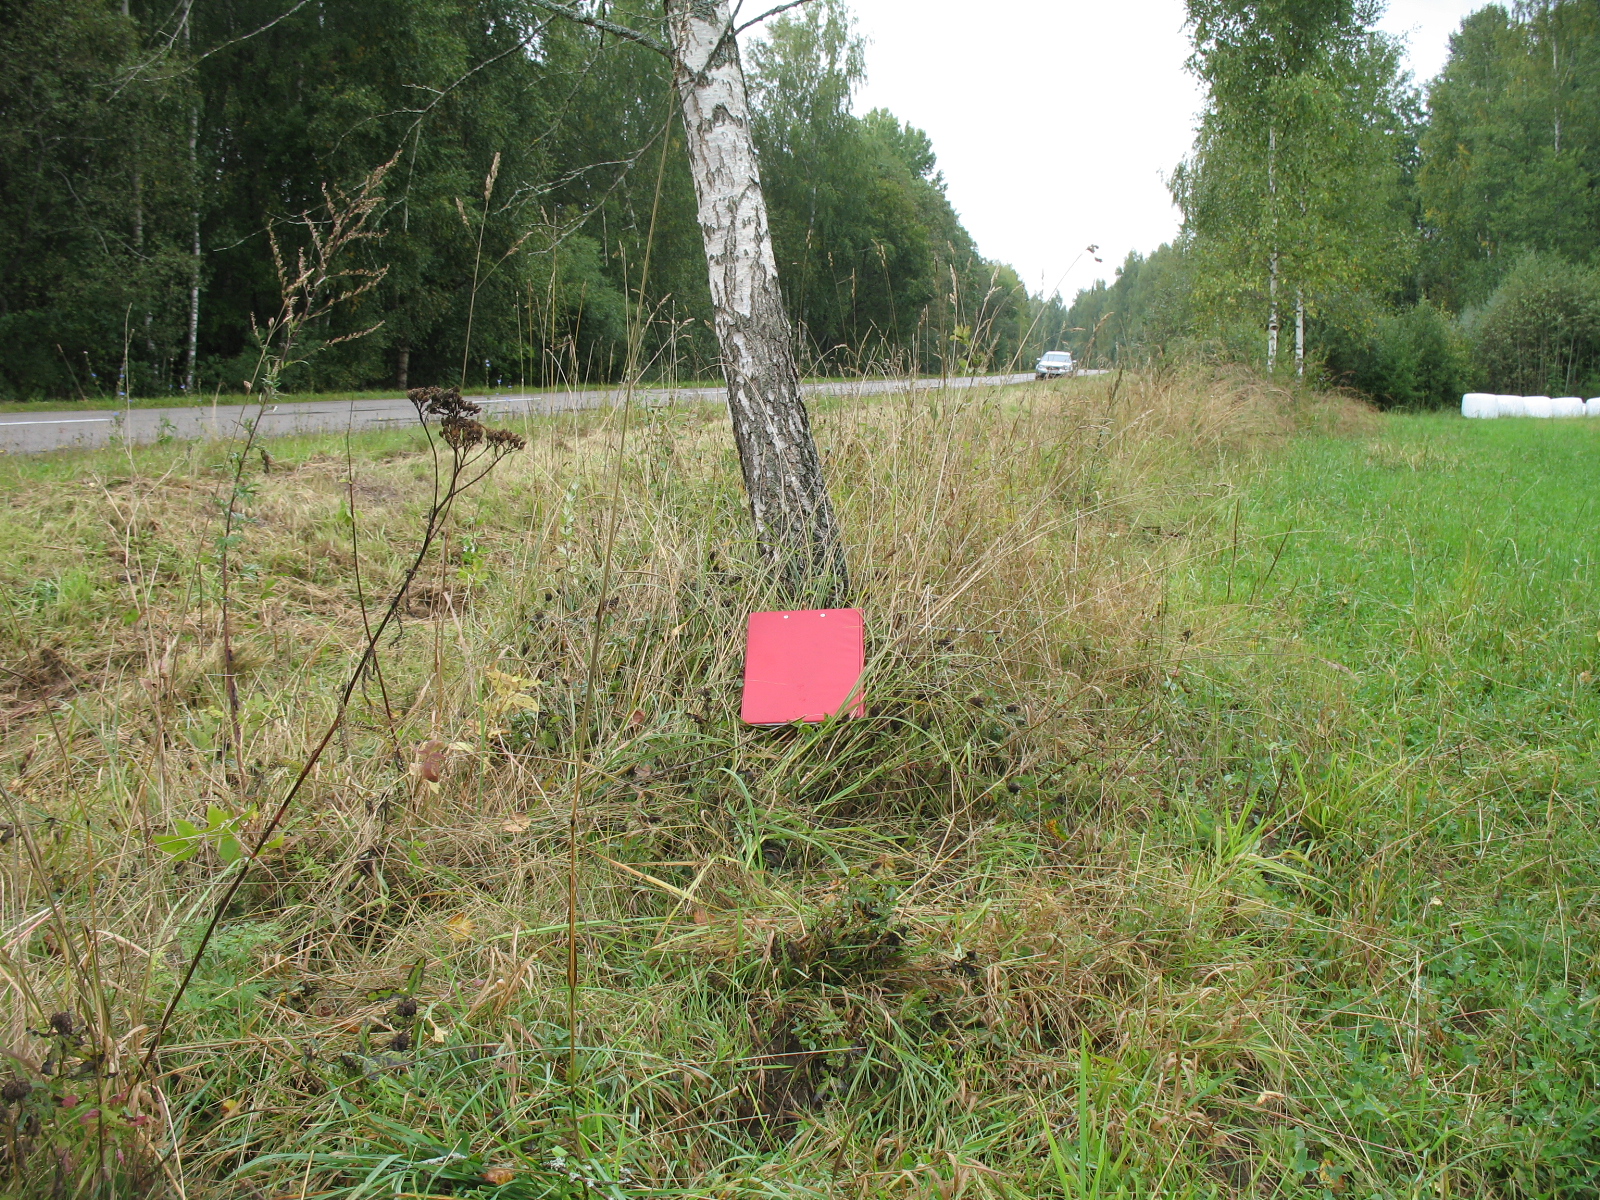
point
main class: Grassland
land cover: Grassland with sparse tree/shrub cover
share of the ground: > 75 %
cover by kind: herbaceous plants 95 %, broadleaved forest trees 5 %
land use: Agriculture (excluding fallow land and kitchen gardens)
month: September
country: LV
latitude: 56.0698
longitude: 25.8910
